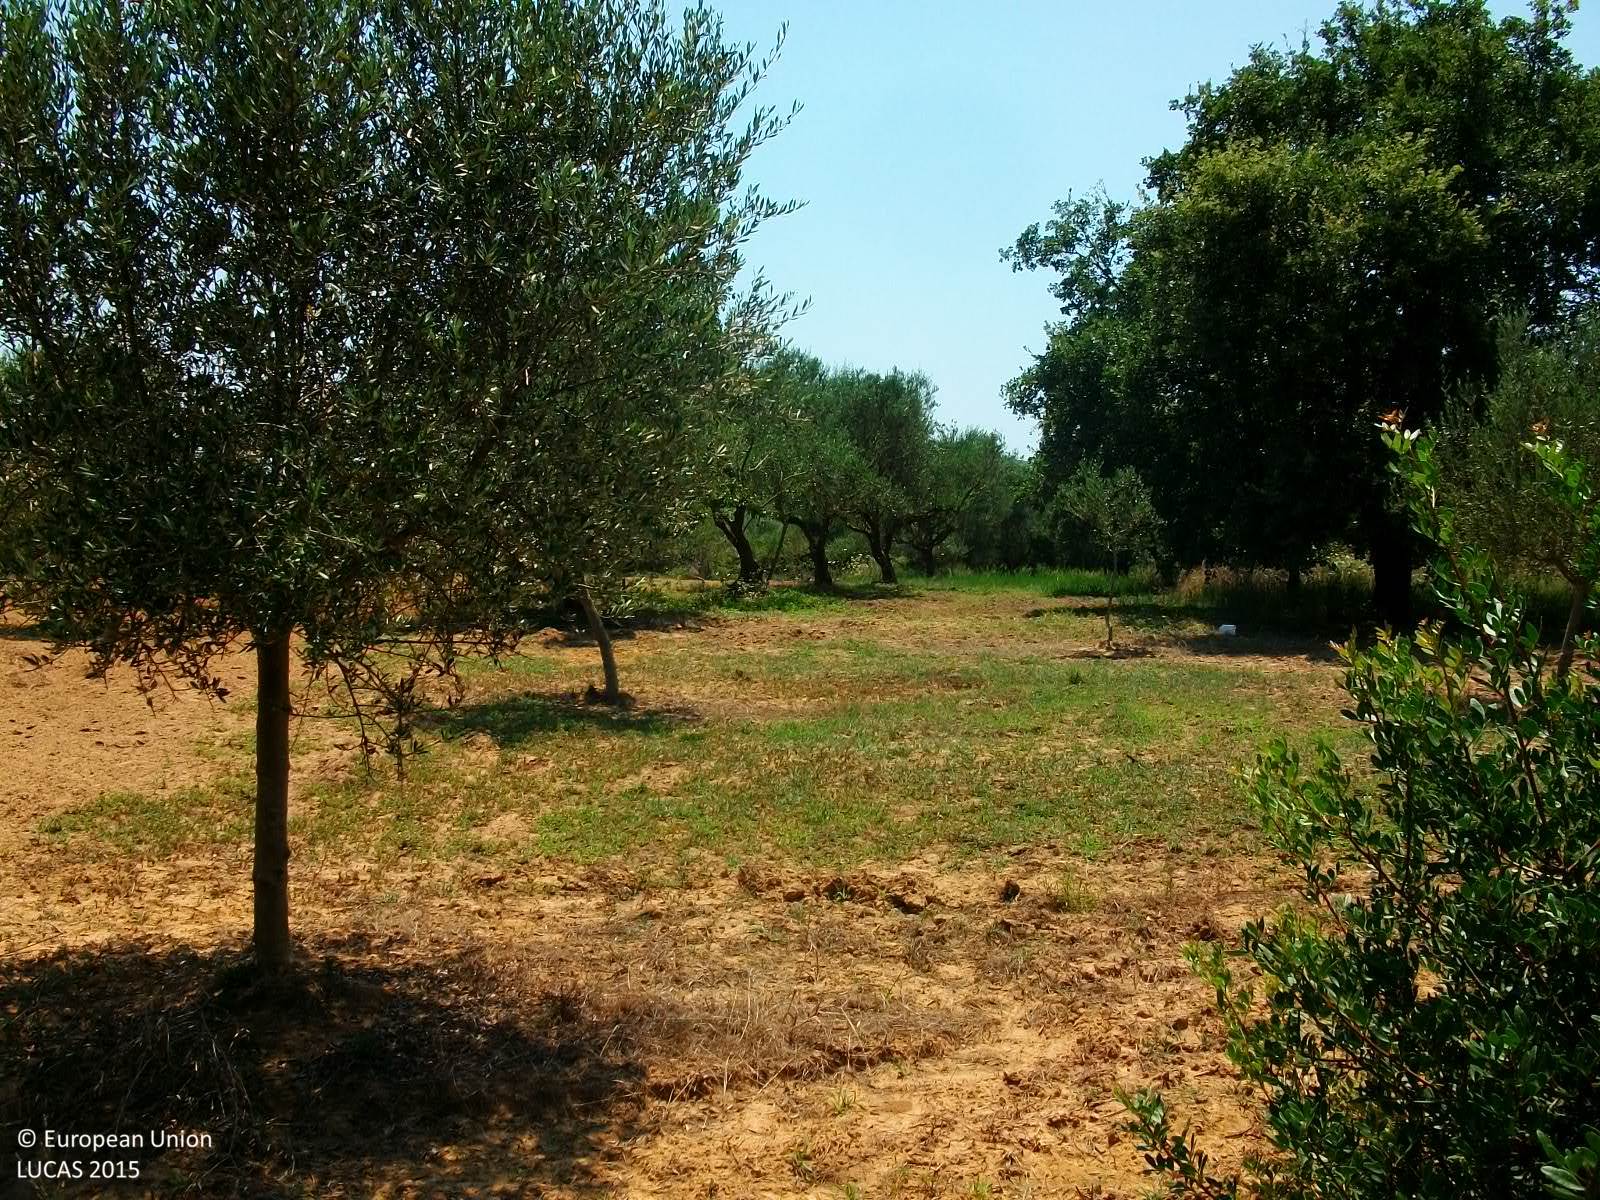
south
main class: Cropland
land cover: Olive groves
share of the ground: < 10 %
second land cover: Spontaneously vegetated surfaces
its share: > 75 %
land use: Agriculture (excluding fallow land and kitchen gardens)
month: July
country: GR
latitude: 37.2073
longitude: 21.9778
